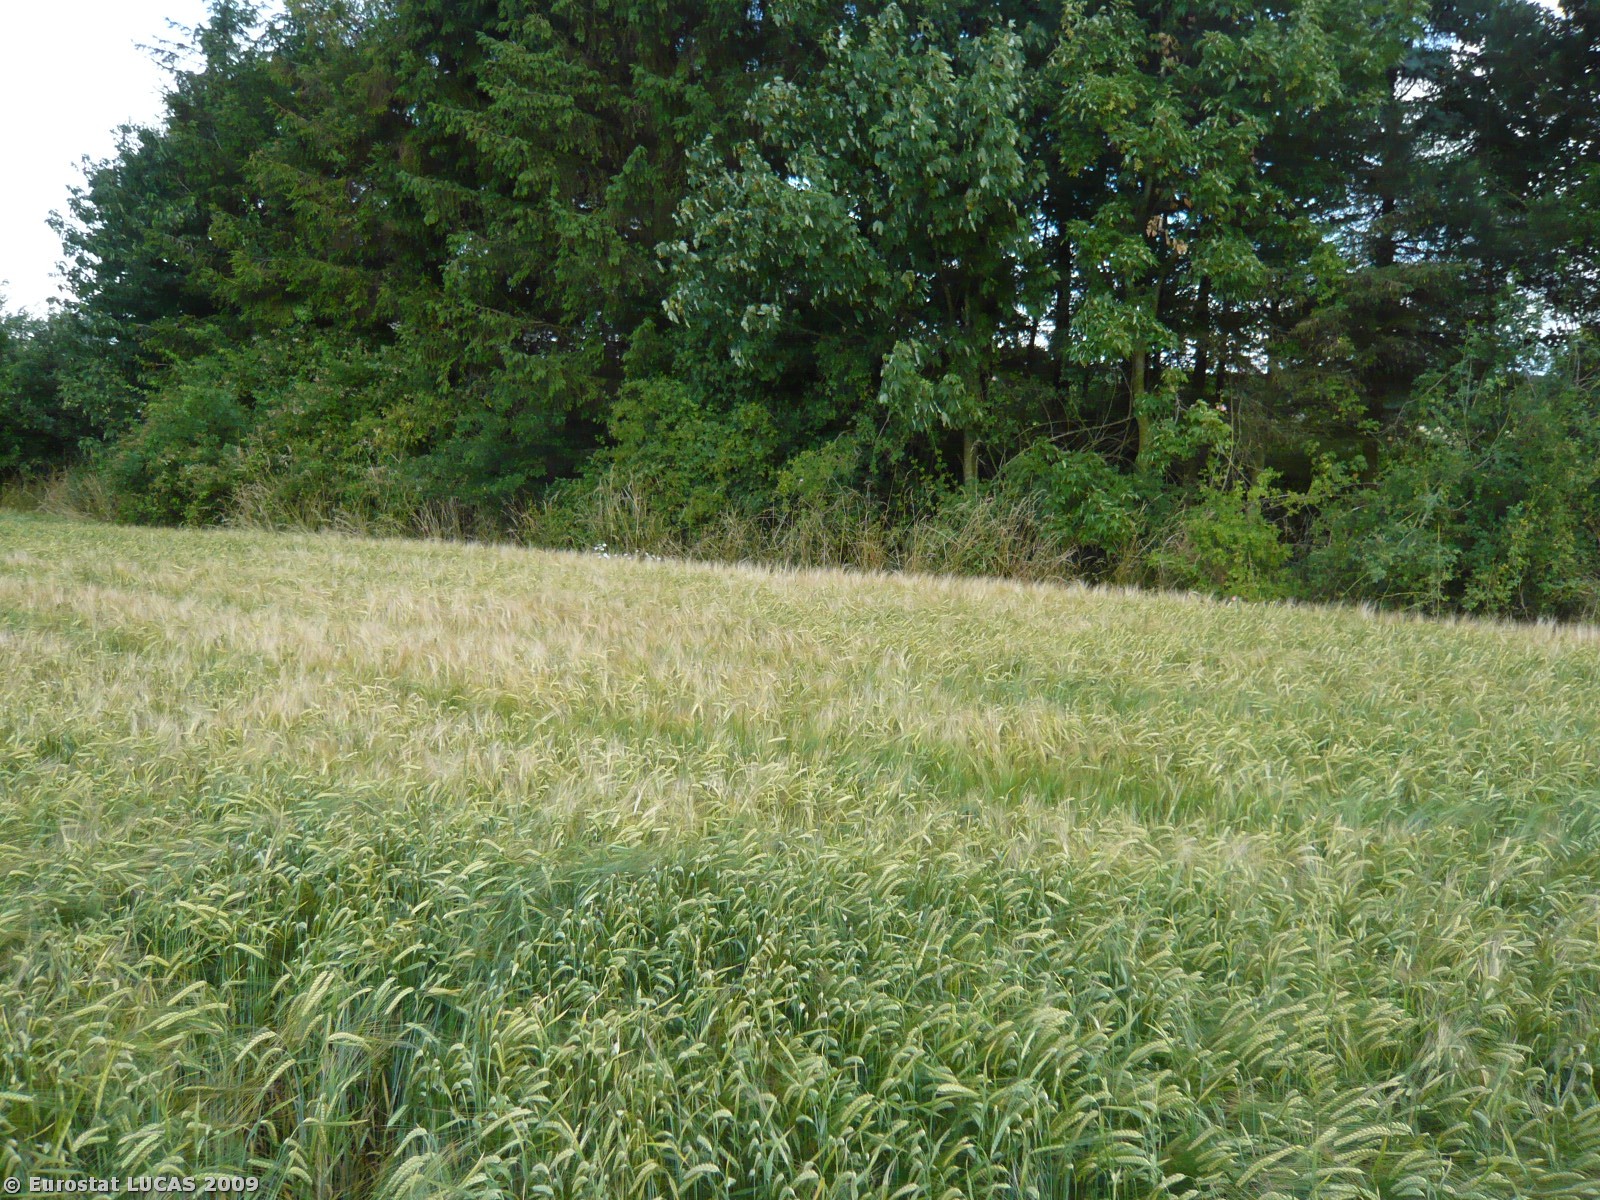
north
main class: Cropland
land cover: Barley
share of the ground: > 75 %
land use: Agriculture (excluding fallow land and kitchen gardens)
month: July
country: DK
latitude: 55.4687
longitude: 10.1422
